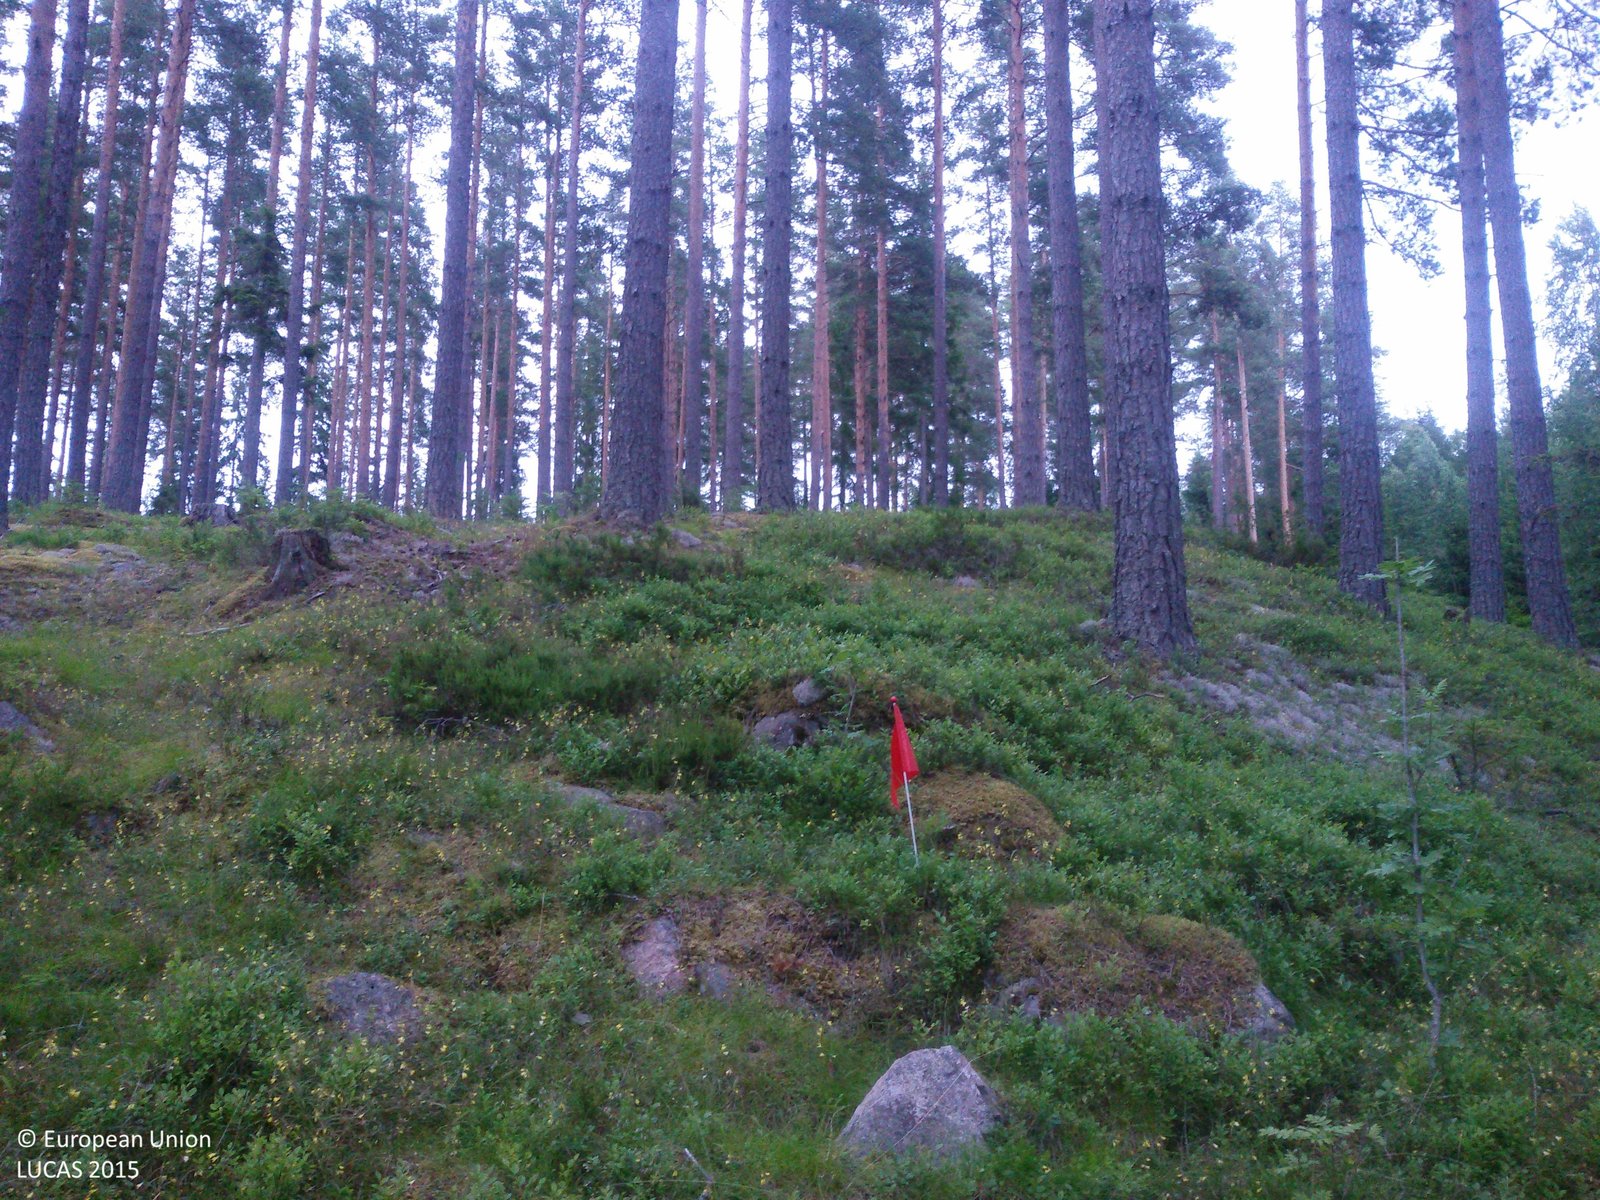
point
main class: Woodland
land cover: Pine dominated coniferous woodland
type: boreal forest
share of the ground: 50 - 75 %
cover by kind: coniferous forest trees 50 %, shrubs 25 %, lichens and mosses 20 %, herbaceous plants 5 %
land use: Forestry
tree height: > 5 m
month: July
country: SE
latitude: 60.4609
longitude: 15.2793
